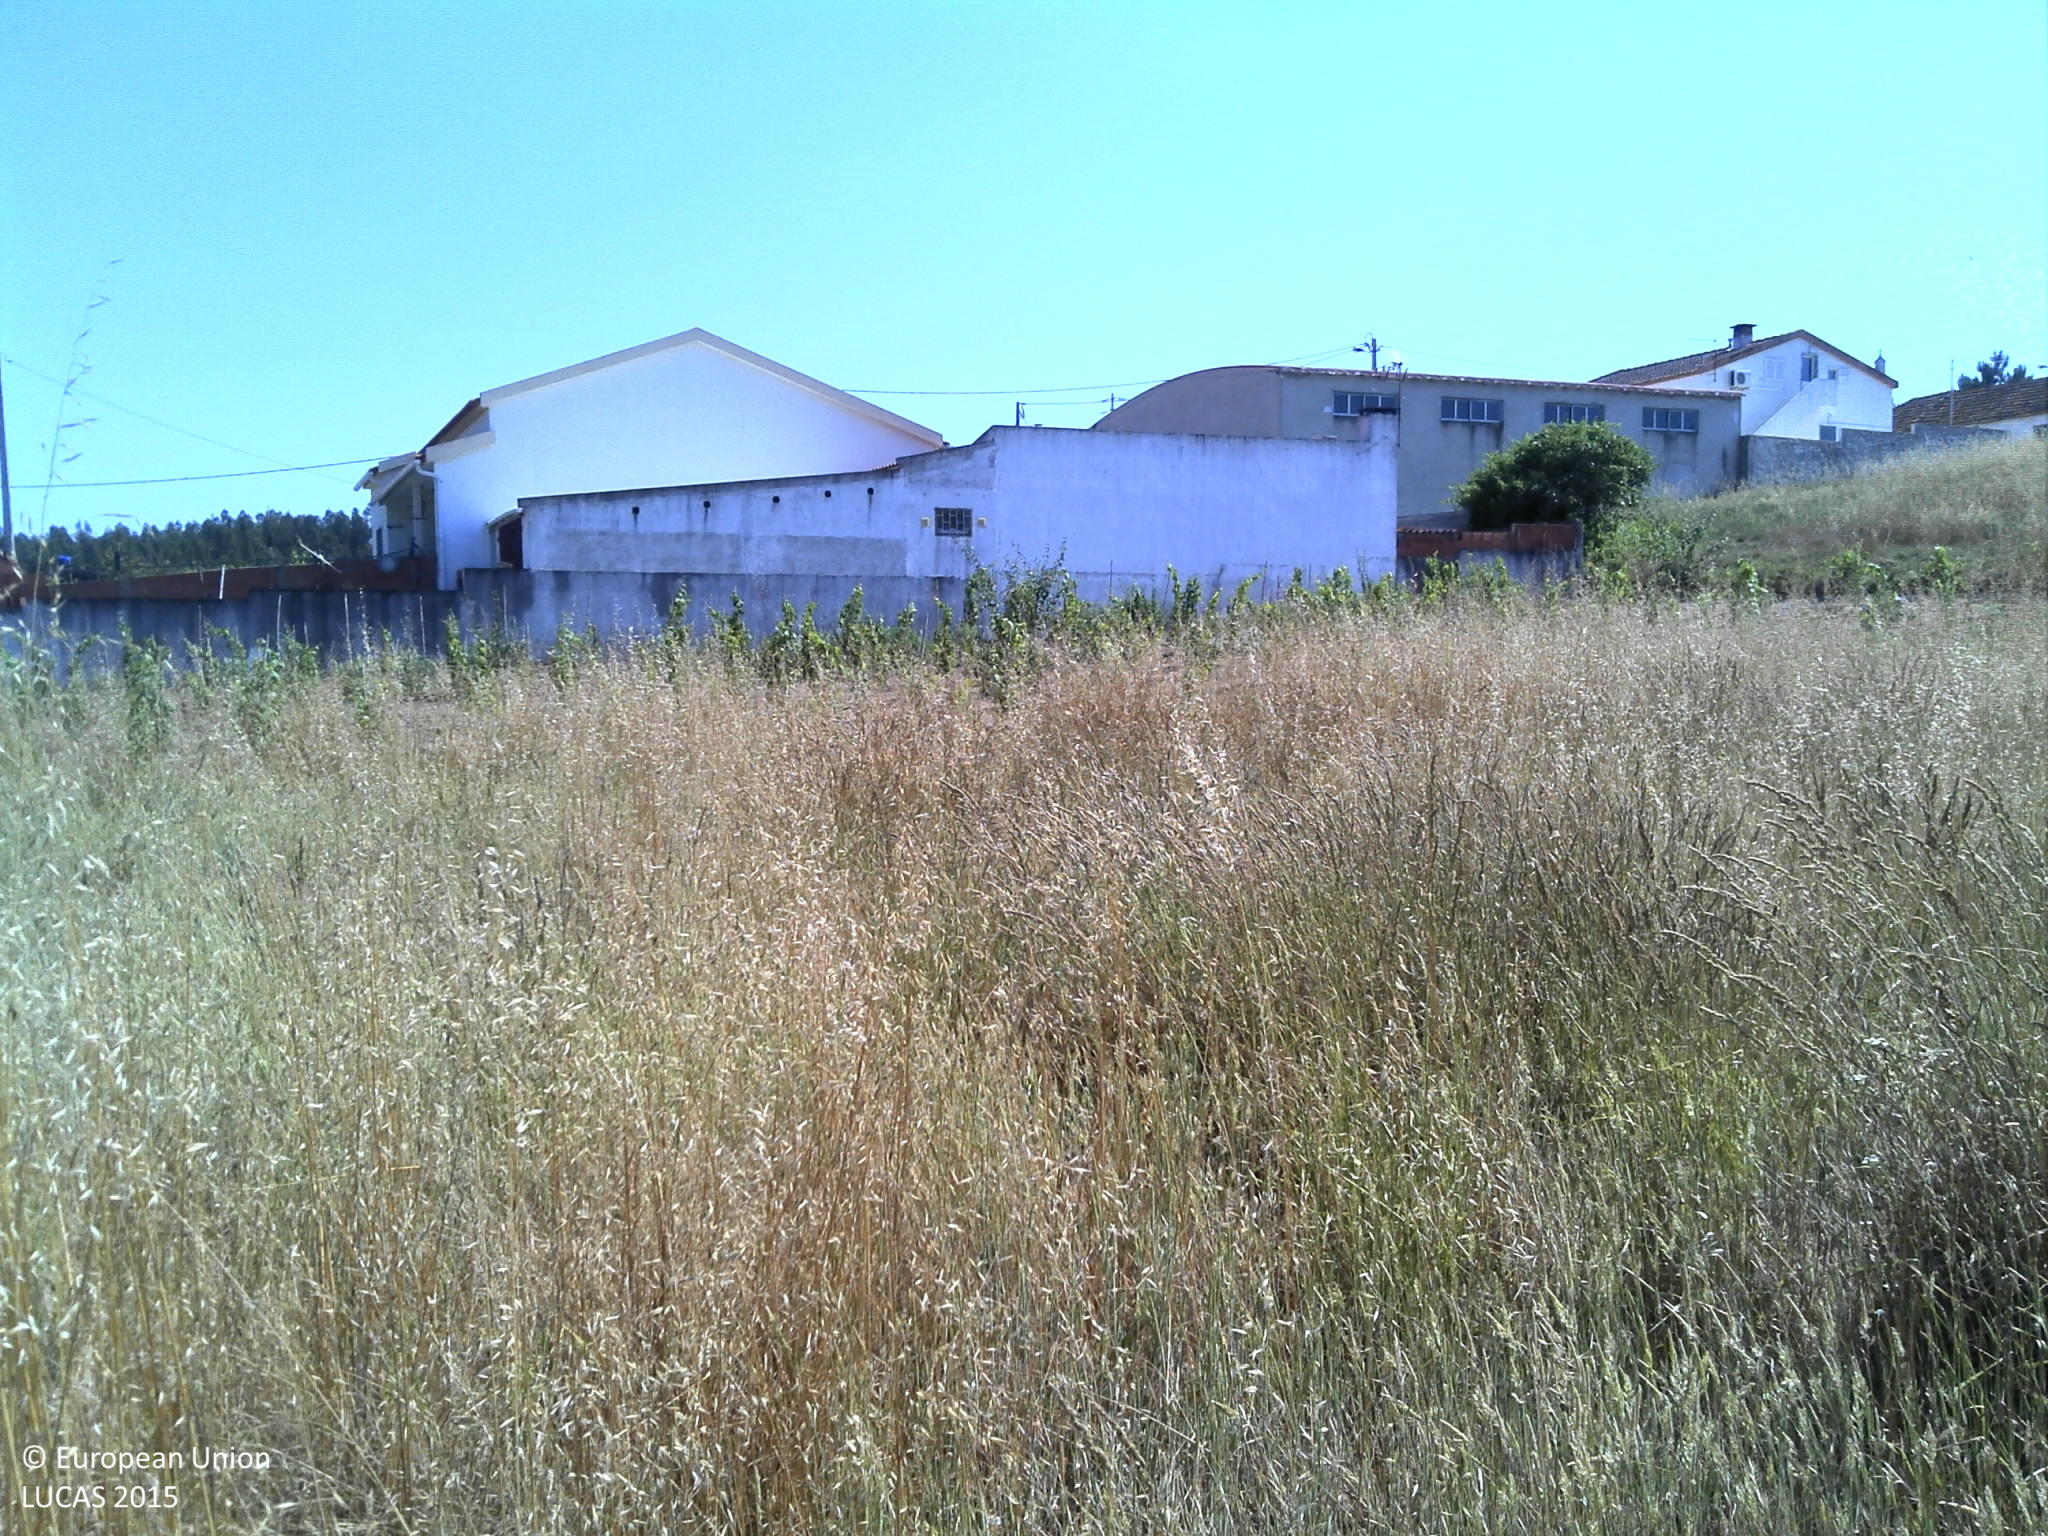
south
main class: Grassland
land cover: Spontaneously vegetated surfaces
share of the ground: > 75 %
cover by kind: herbaceous plants 80 %, unconsolidated bare surface 20 %
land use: Fallow land
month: June
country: PT
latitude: 39.1712
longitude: -9.2673
